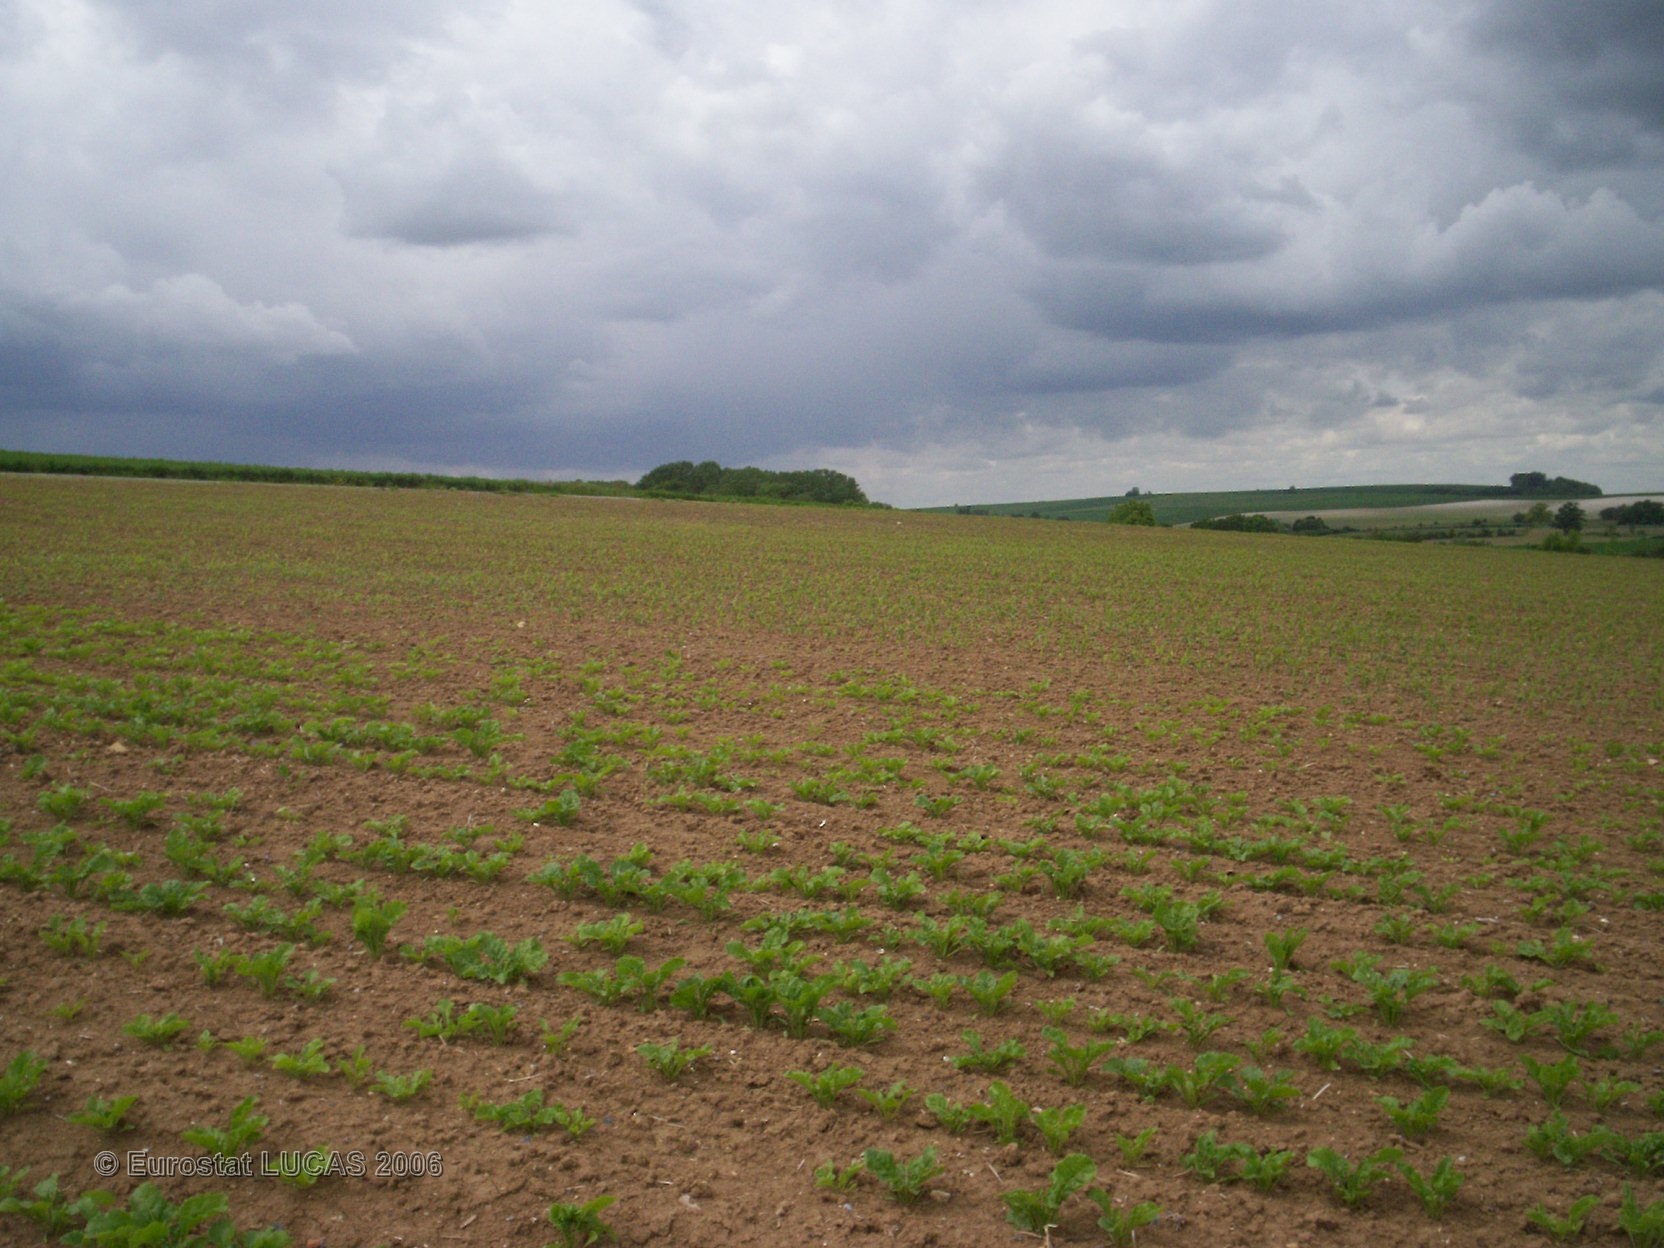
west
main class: Cropland
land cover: Sugar beet
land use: Agriculture (excluding fallow land and kitchen gardens)
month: May
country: FR
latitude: 49.5418
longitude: 4.3989
